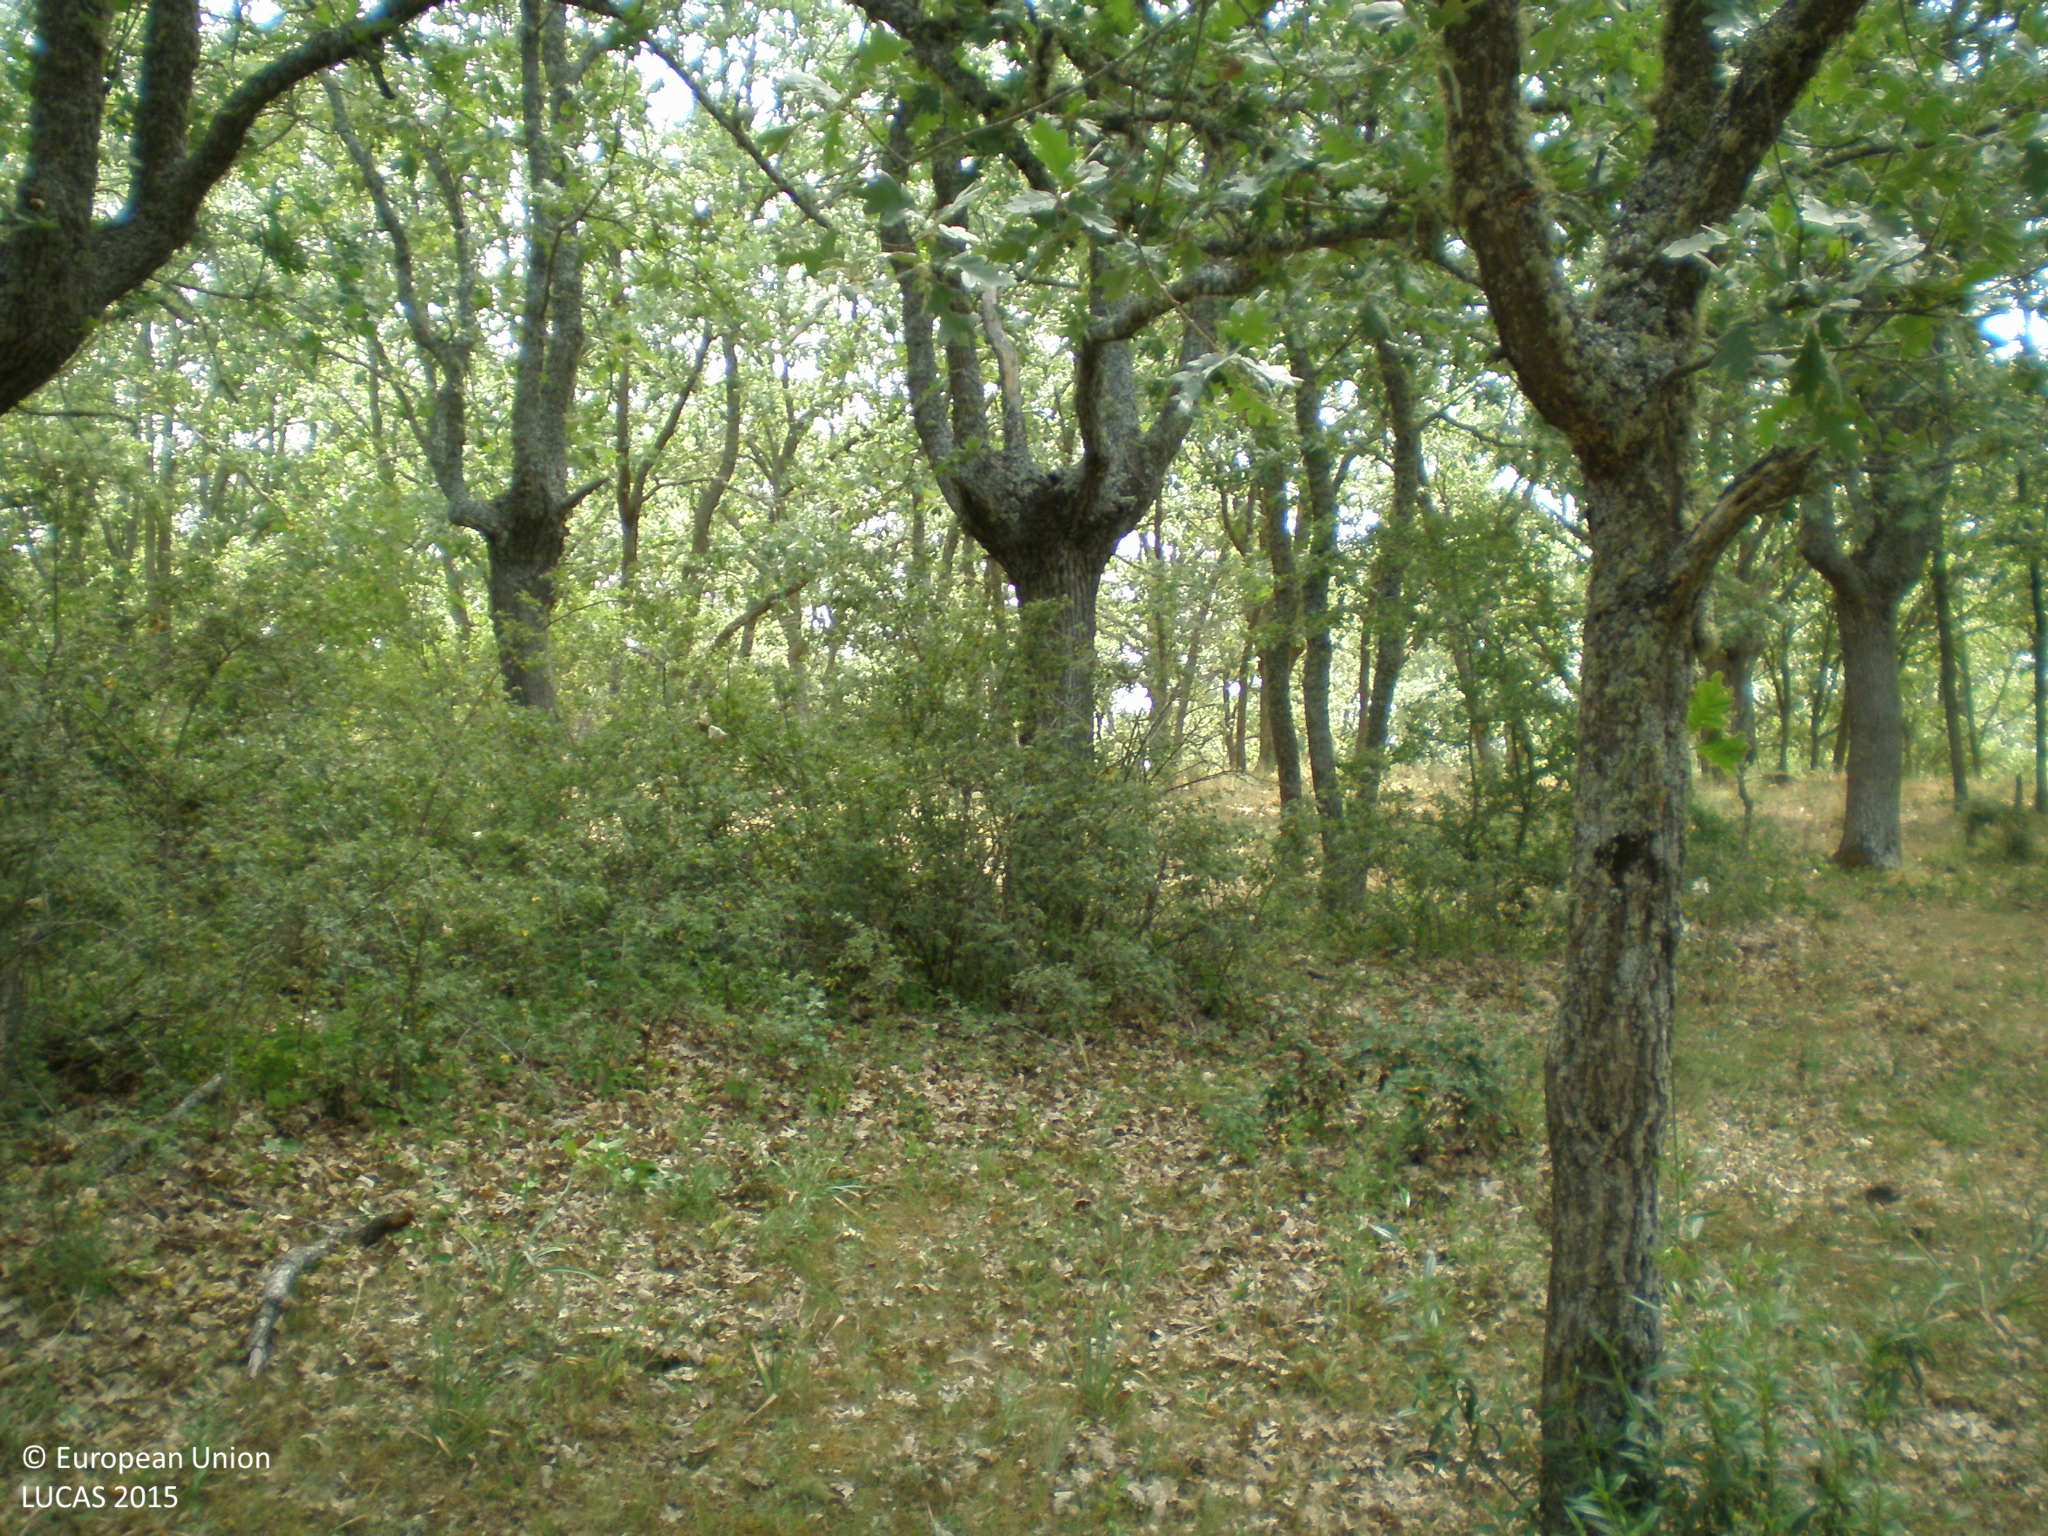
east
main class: Woodland
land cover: Broadleaved woodland
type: thermophilous deciduous forest
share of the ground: > 75 %
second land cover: Grassland without tree/shrub cover
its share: 10 - 25 %
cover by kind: broadleaved forest trees 80 %, herbaceous plants 20 %
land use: Forestry
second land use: Agriculture (excluding fallow land and kitchen gardens)
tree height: > 5 m
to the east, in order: Broadleaved woodland; Grassland without tree/shrub cover
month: June
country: ES
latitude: 41.2183
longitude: -5.8169
